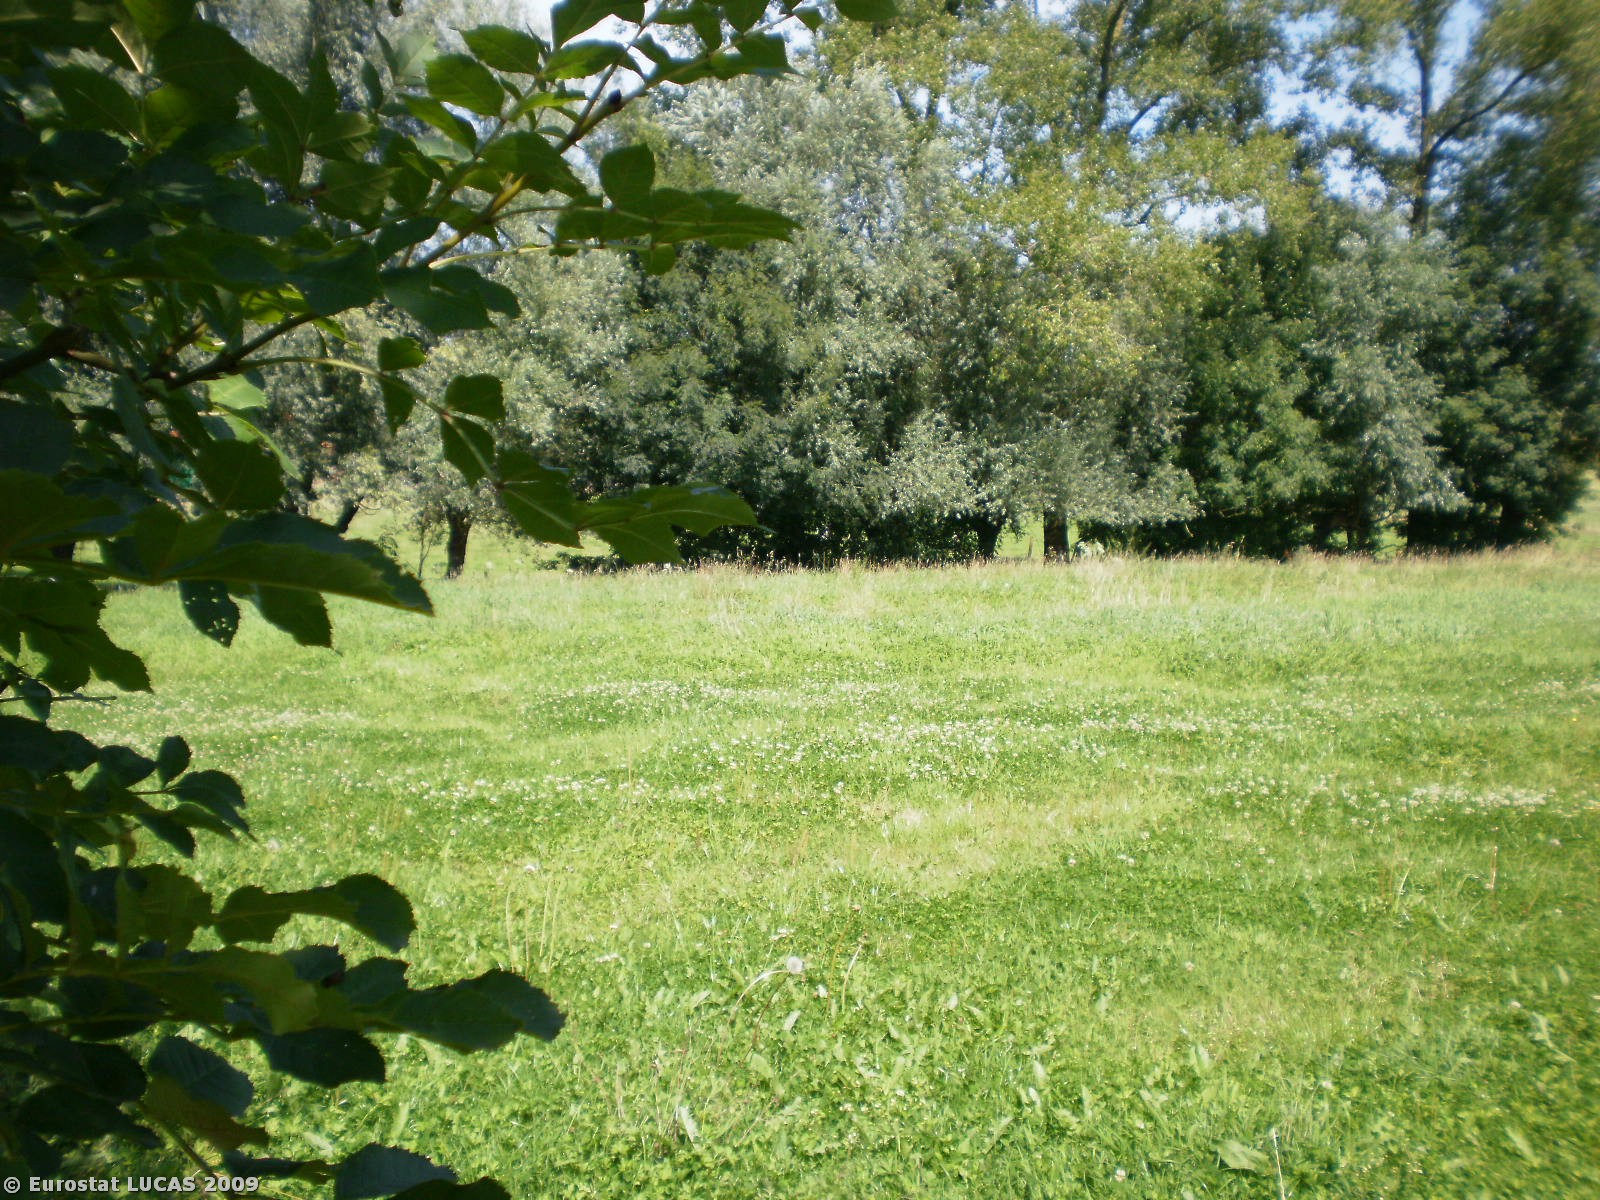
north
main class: Grassland
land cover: Grassland without tree/shrub cover
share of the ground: > 75 %
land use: Agriculture (excluding fallow land and kitchen gardens)
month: August
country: BE
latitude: 50.8429
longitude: 3.7587
